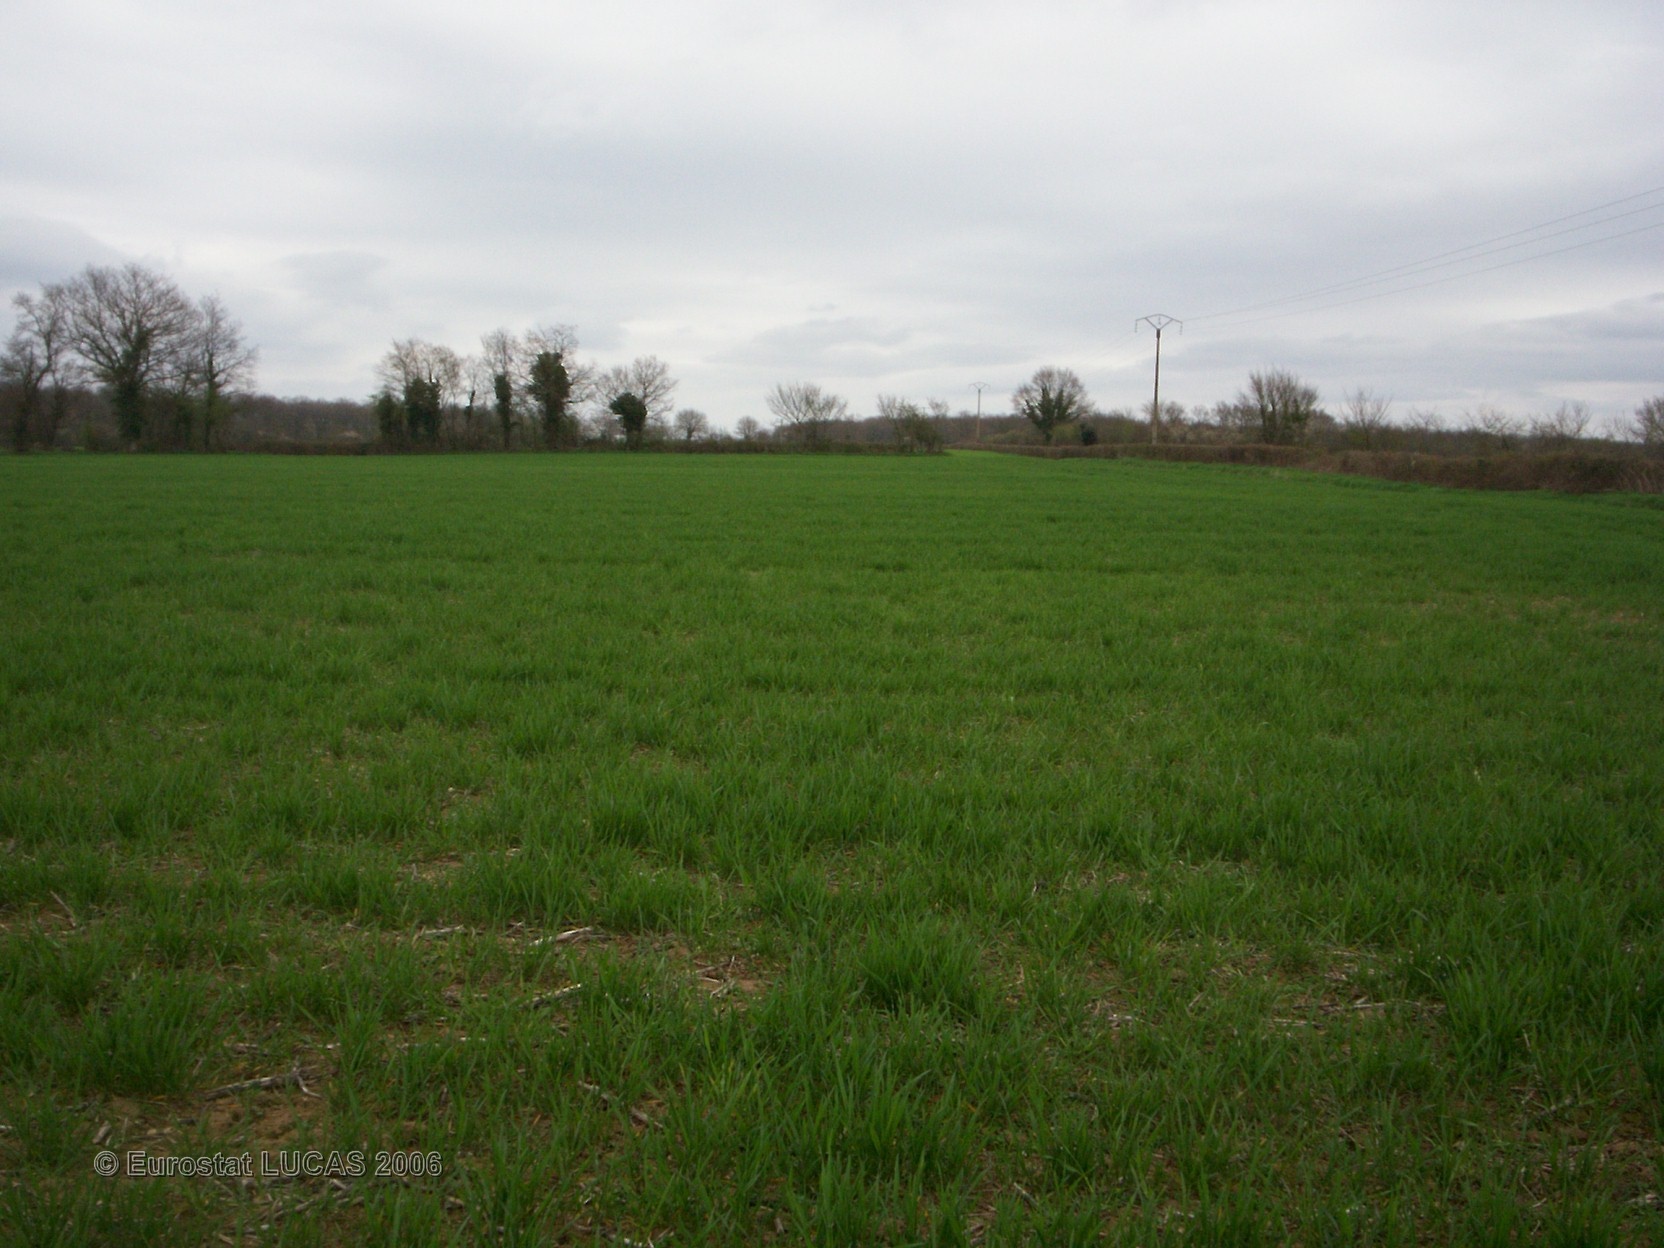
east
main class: Cropland
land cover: Common wheat
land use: Agriculture (excluding fallow land and kitchen gardens)
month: April
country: FR
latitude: 46.7214
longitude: 3.0494
